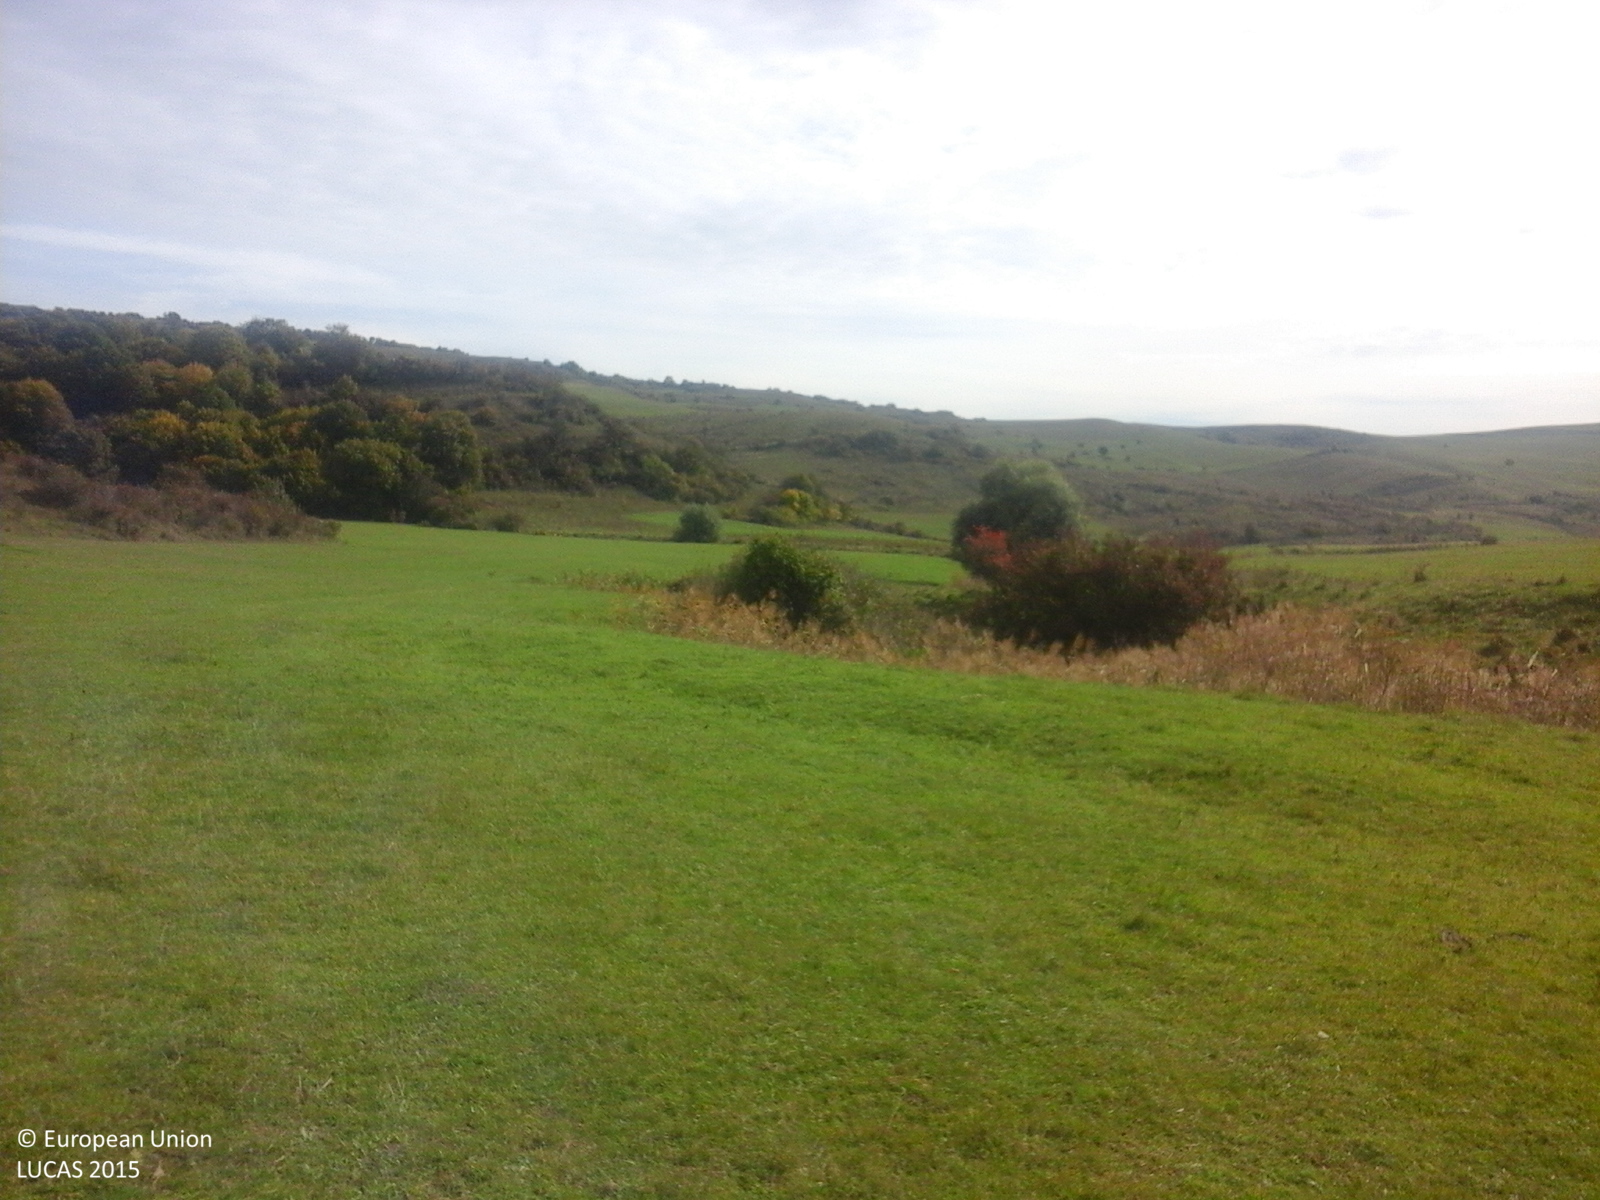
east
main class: Grassland
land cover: Grassland without tree/shrub cover
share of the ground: > 75 %
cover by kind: herbaceous plants 100 %
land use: Agriculture (excluding fallow land and kitchen gardens)
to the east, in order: Grassland without tree/shrub cover; Spontaneously vegetated surfaces; Rivers and streams
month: October
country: RO
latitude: 46.2130
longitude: 25.1743
